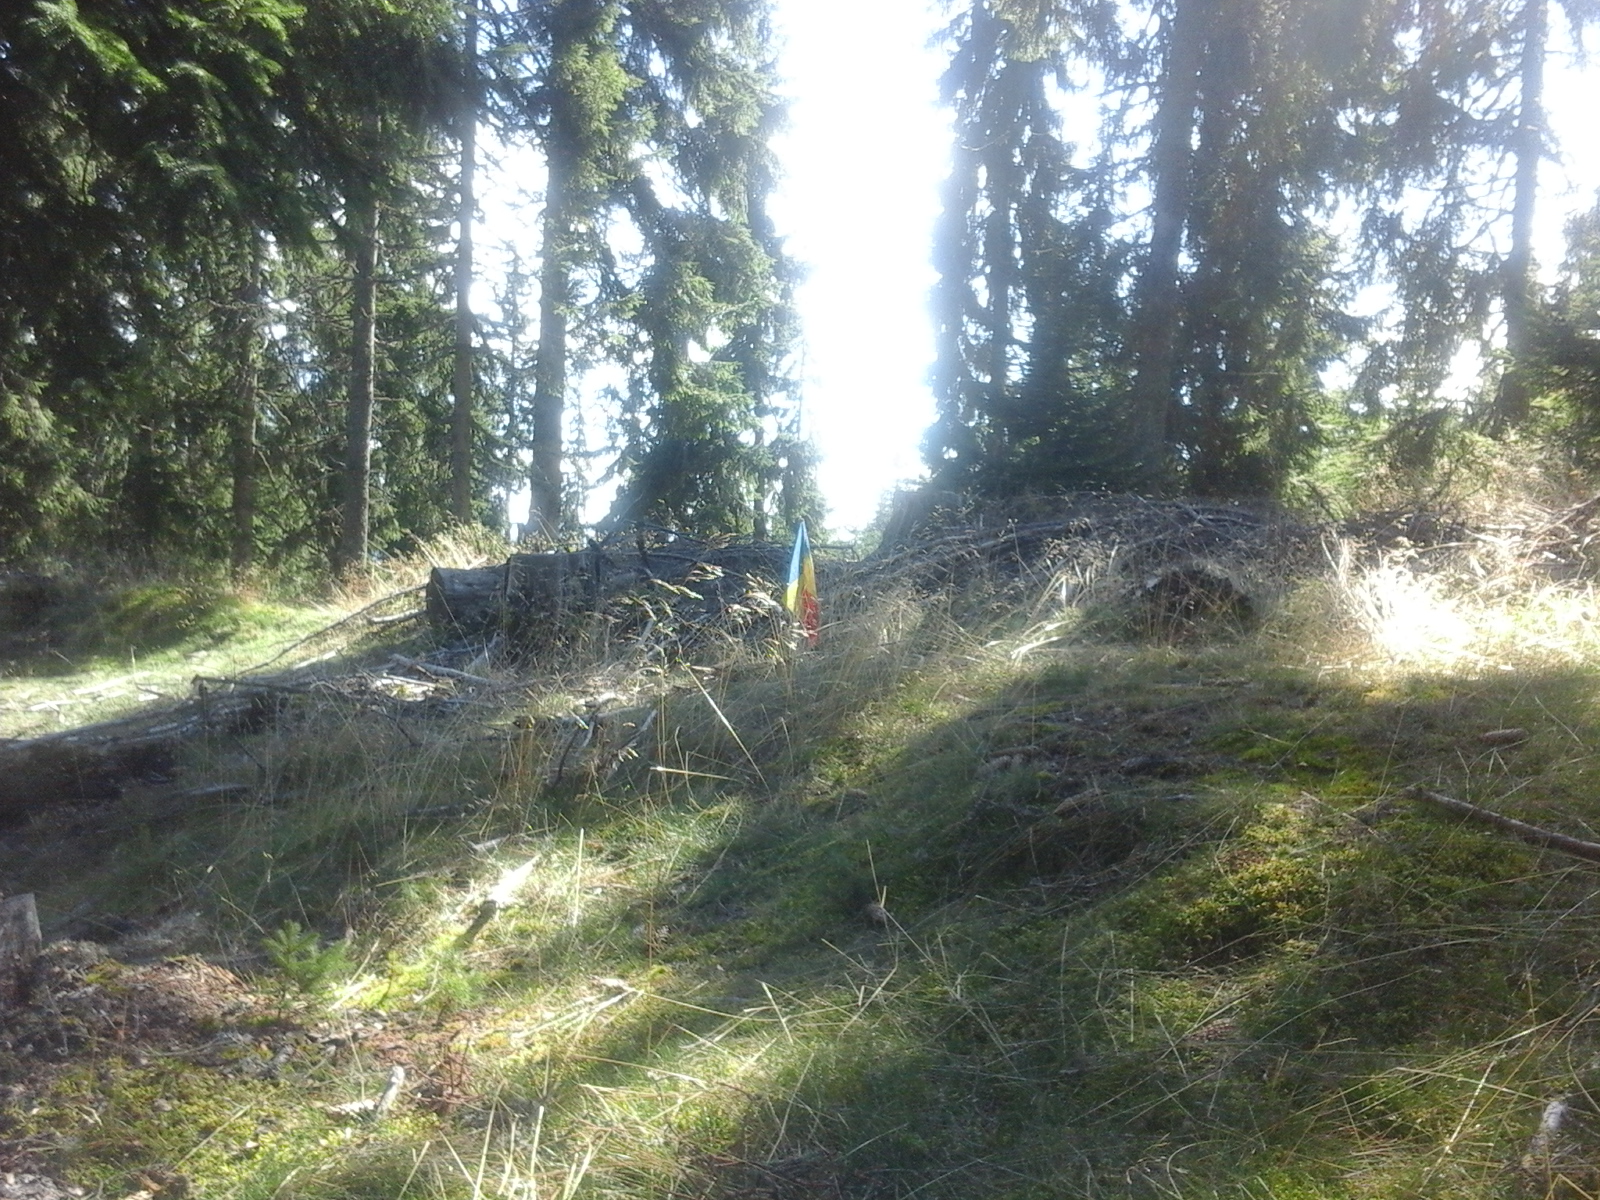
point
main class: Woodland
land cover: Spruce dominated coniferous woodland
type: alpine coniferous forest
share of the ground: > 75 %
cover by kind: coniferous forest trees 100 %
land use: Forestry
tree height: > 5 m
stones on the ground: 25 - 50 %
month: October
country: RO
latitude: 46.5407
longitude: 22.9818
